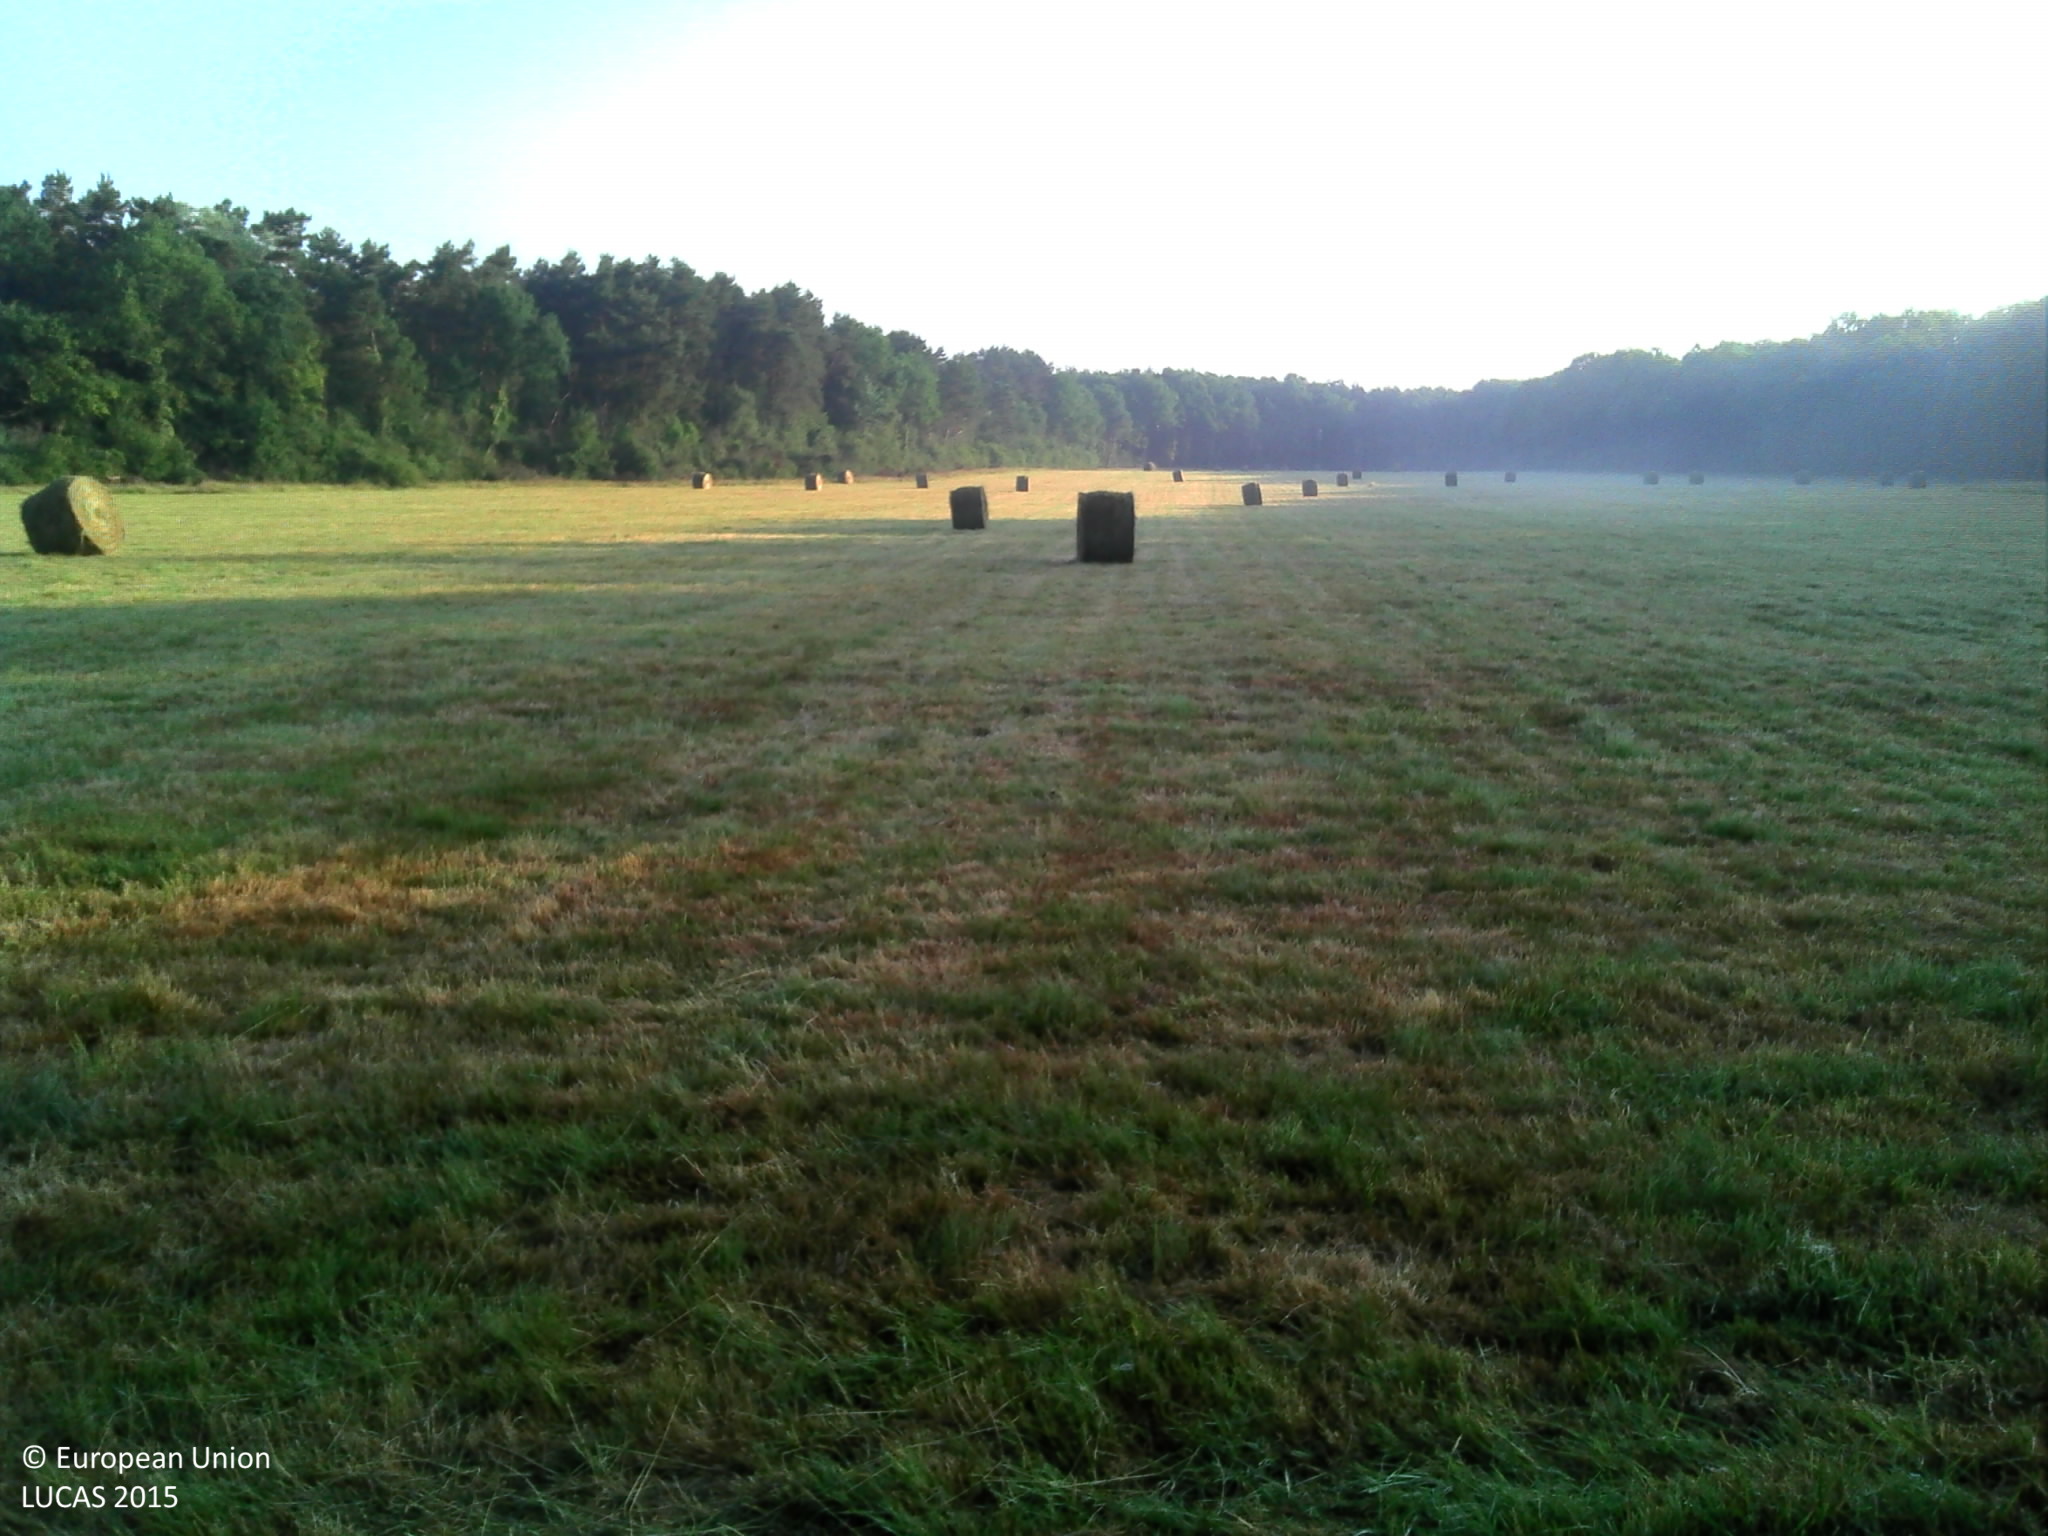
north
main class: Grassland
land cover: Grassland without tree/shrub cover
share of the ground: > 75 %
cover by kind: herbaceous plants 100 %
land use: Agriculture (excluding fallow land and kitchen gardens)
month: June
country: FR
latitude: 46.7850
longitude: 2.6464
